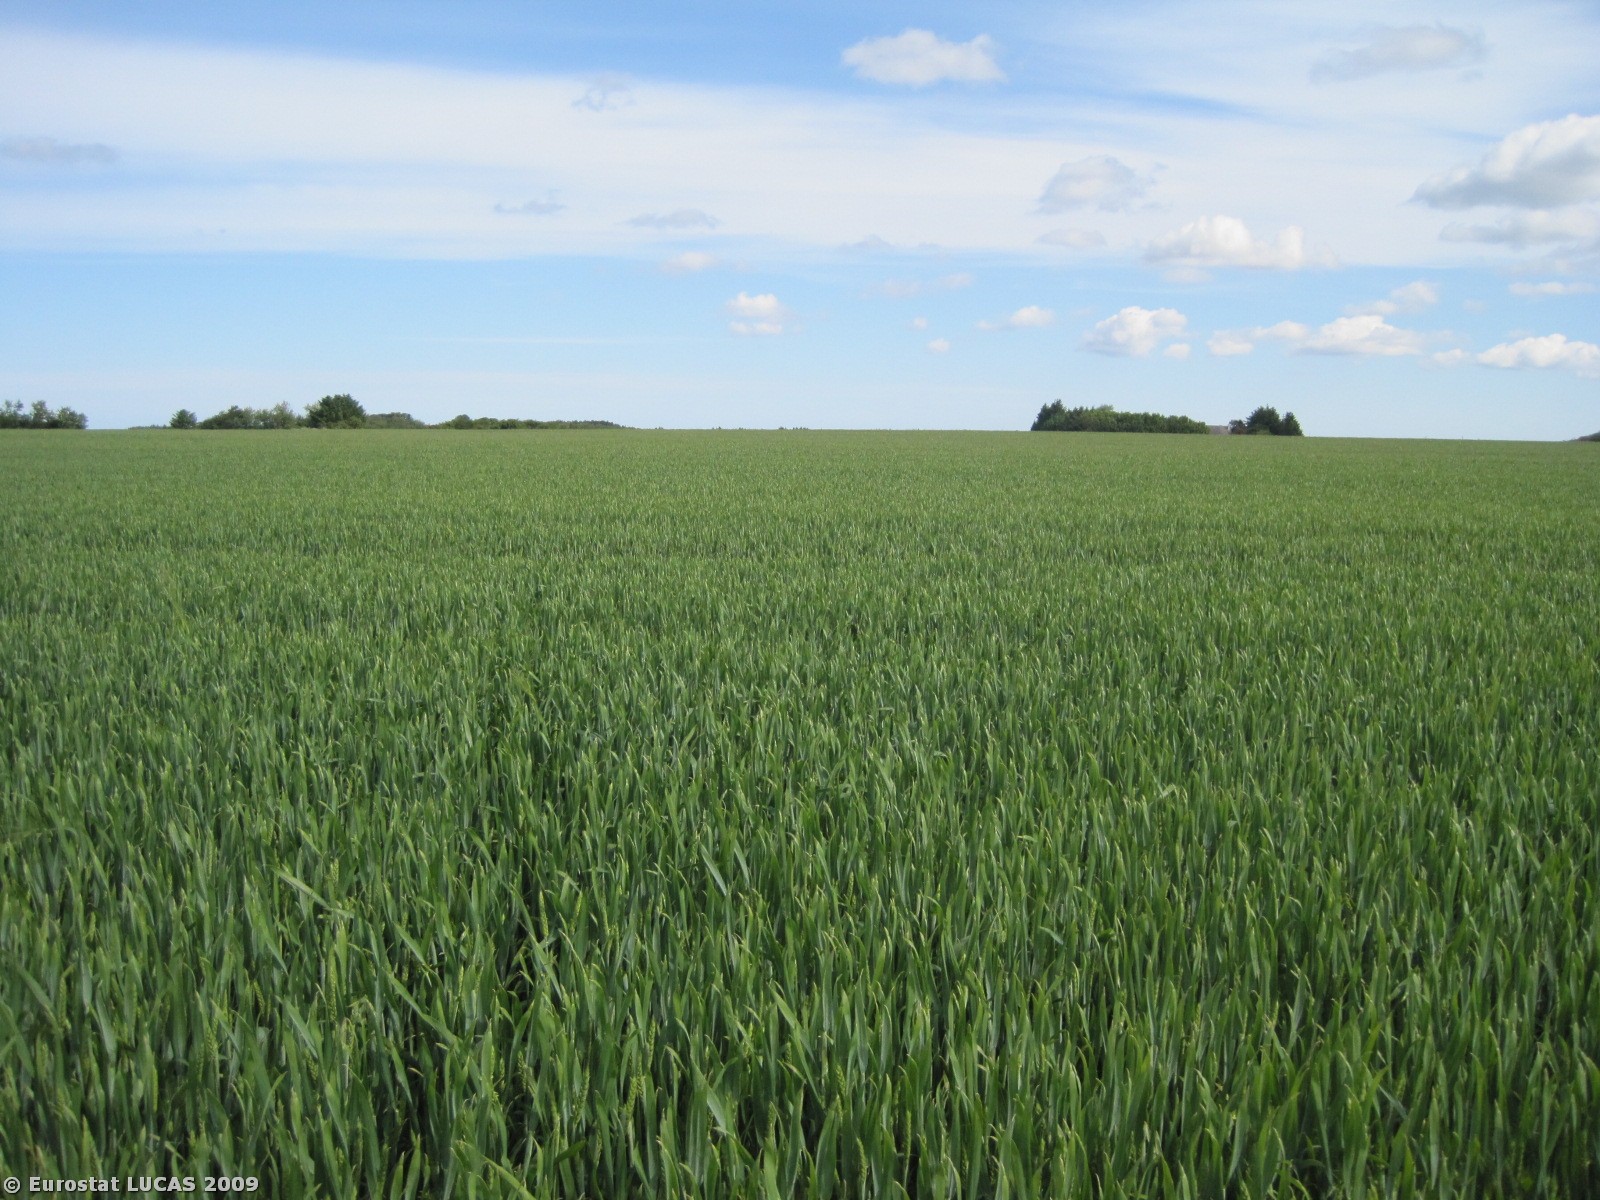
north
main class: Cropland
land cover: Common wheat
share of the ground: > 75 %
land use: Agriculture (excluding fallow land and kitchen gardens)
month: June
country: DK
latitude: 57.4101
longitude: 9.8504
